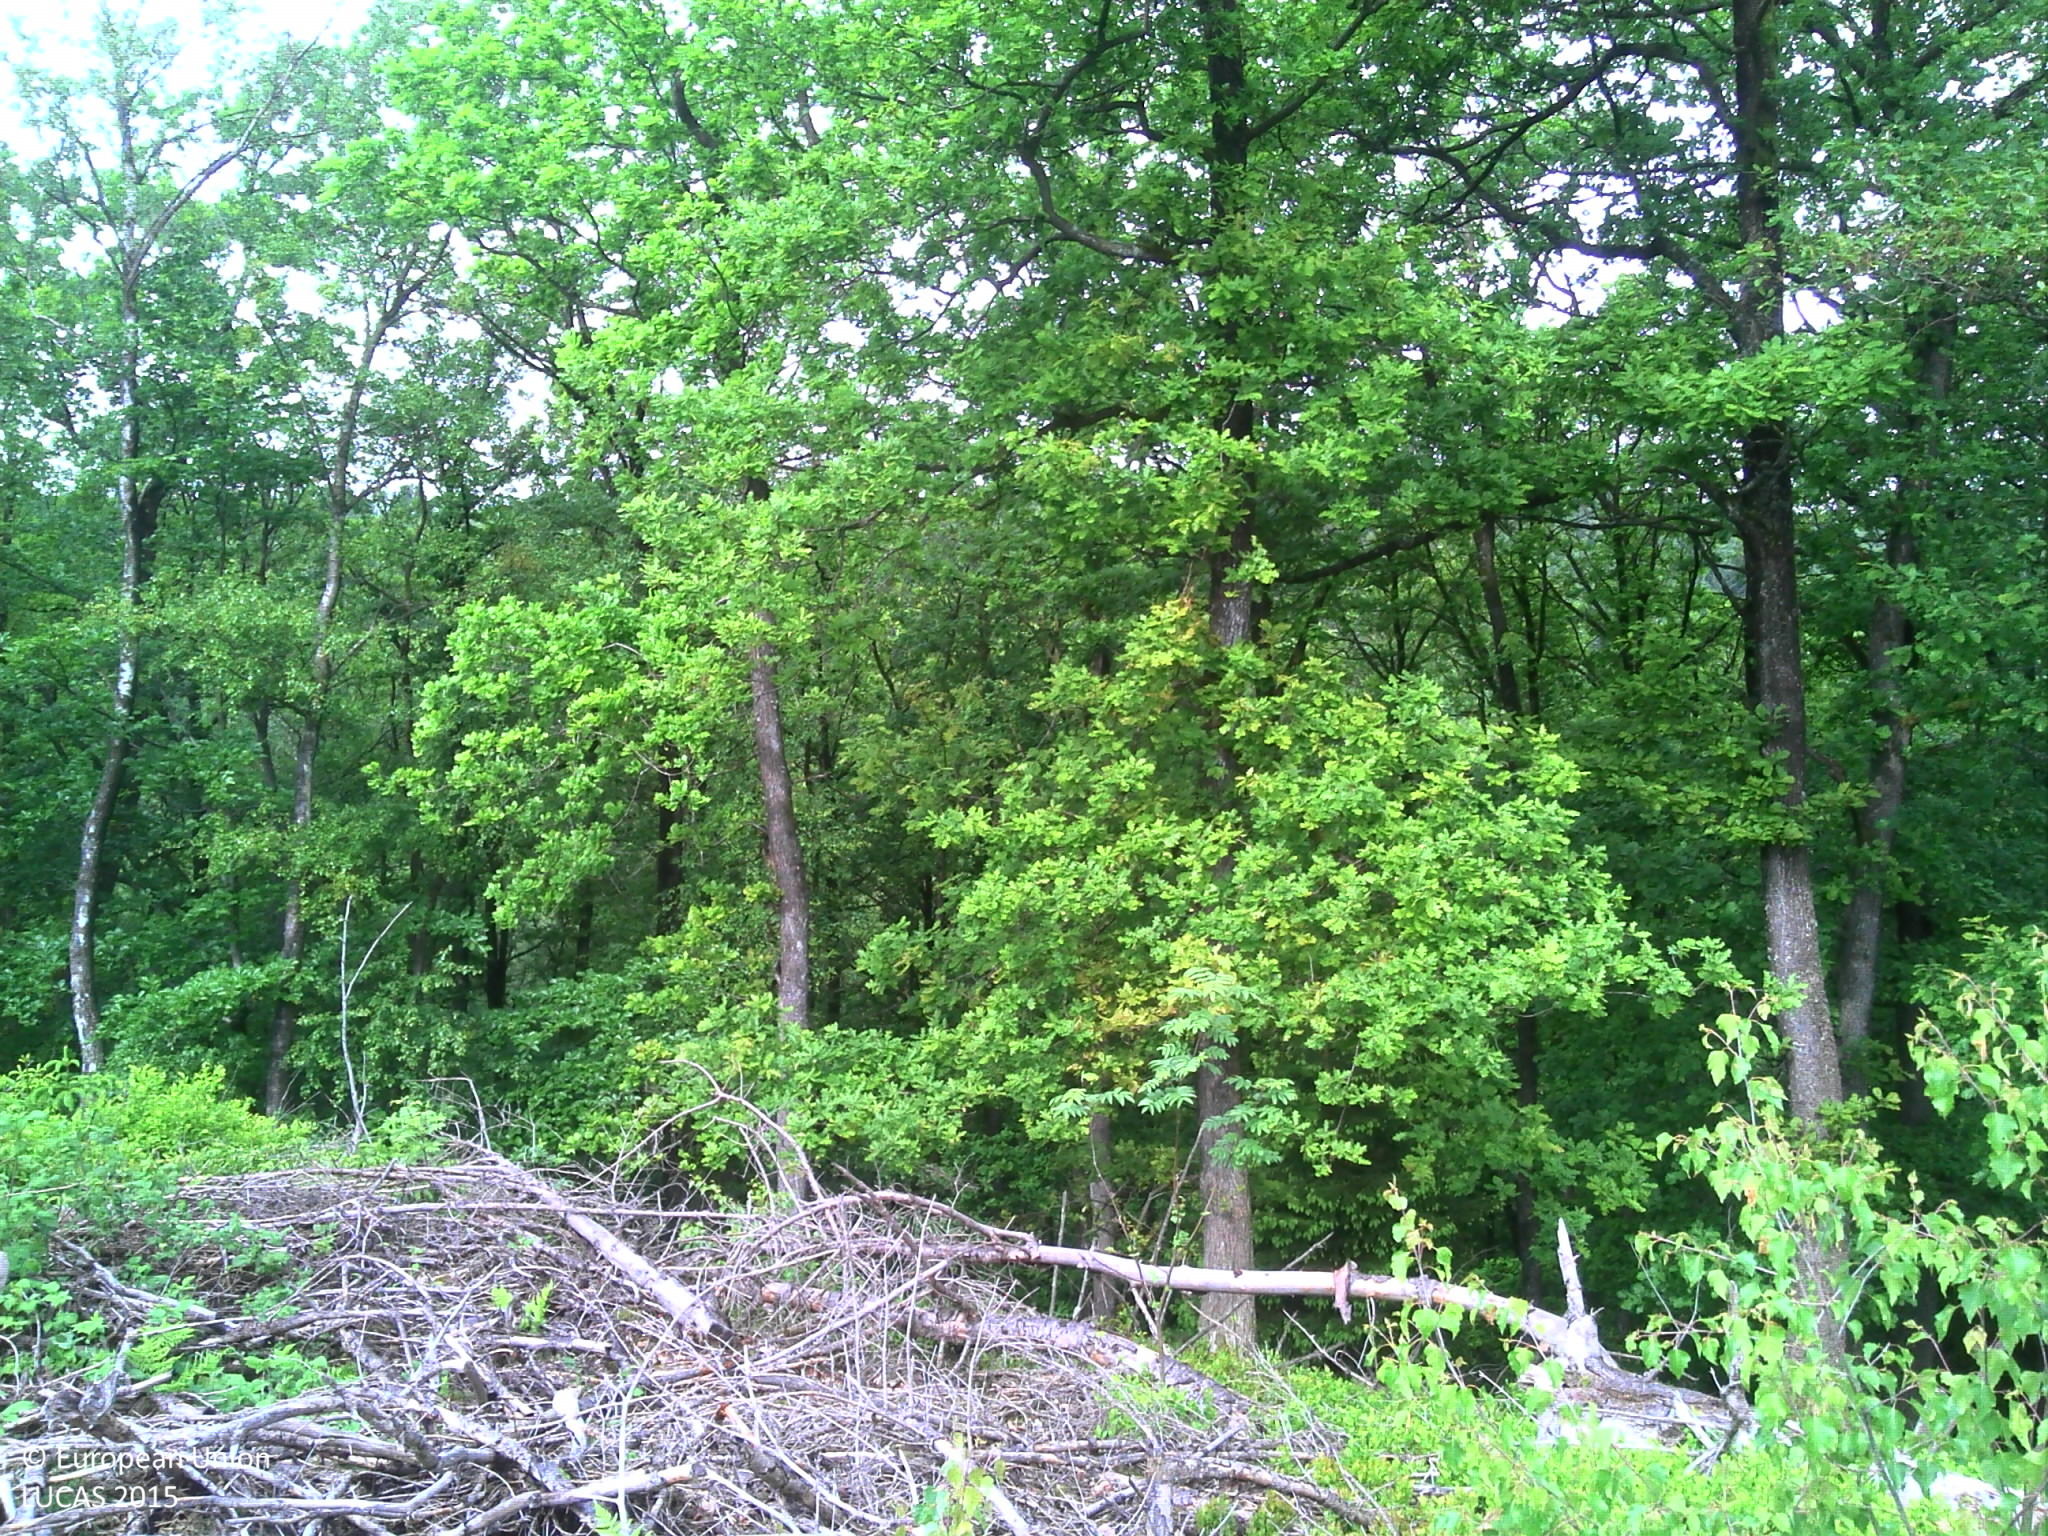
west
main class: Shrubland
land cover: Shrubland without tree cover
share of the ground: > 75 %
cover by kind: shrubs 60 %, herbaceous plants 40 %
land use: Forestry
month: June
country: BE
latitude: 50.2681
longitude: 5.7758
